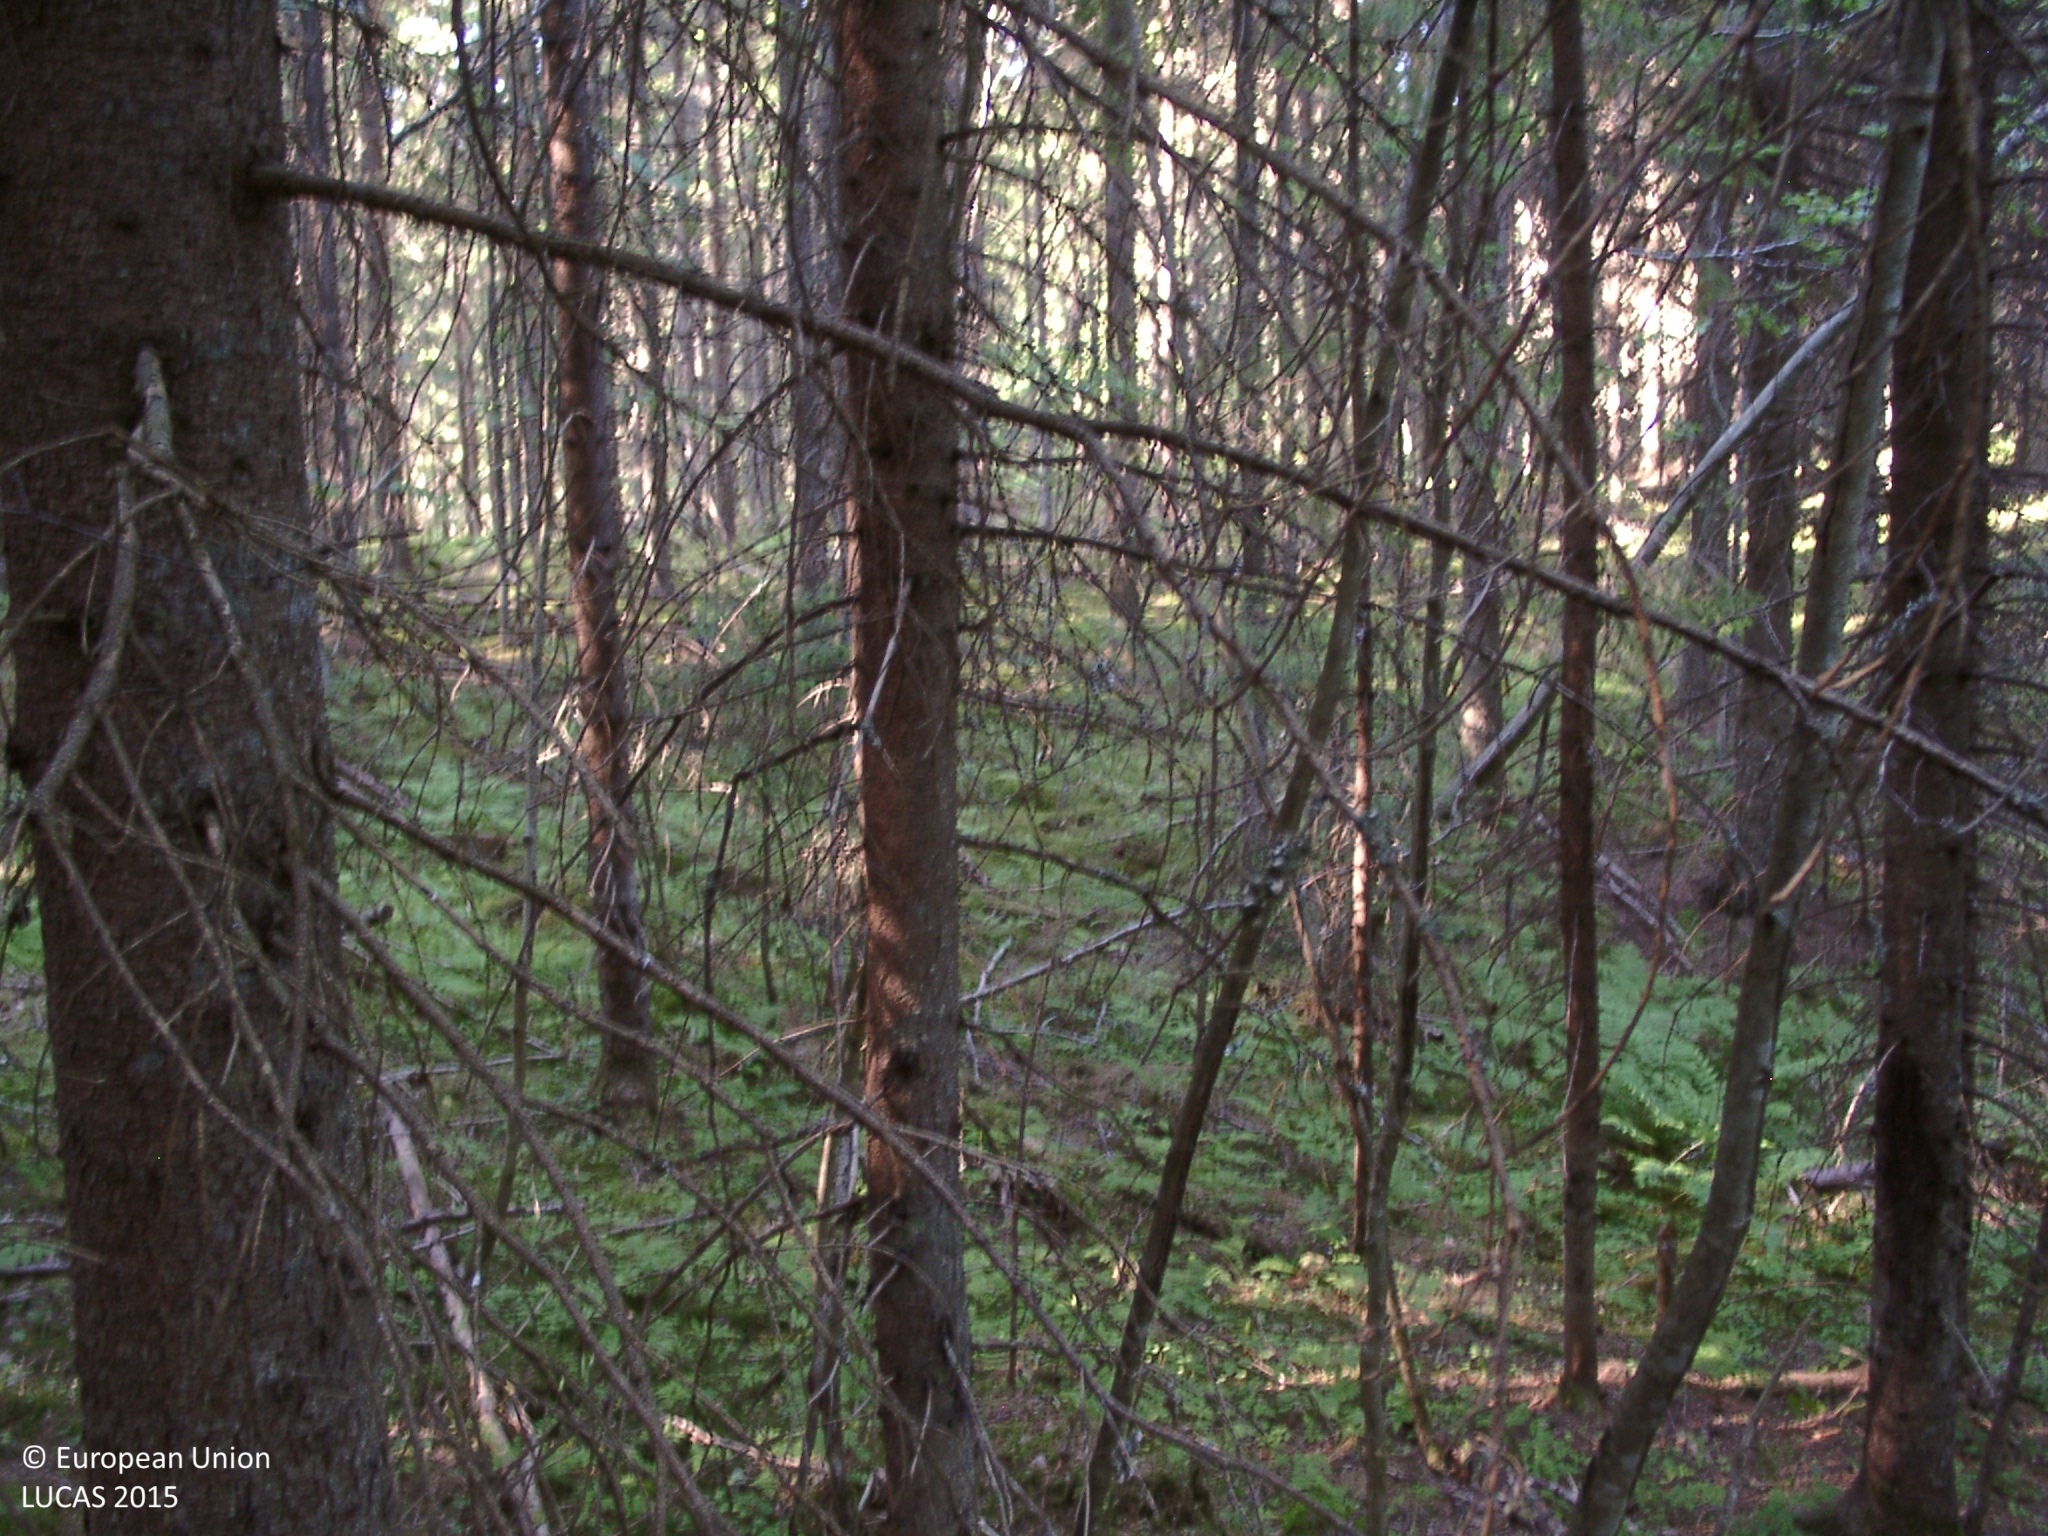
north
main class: Woodland
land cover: Spruce dominated mixed woodland
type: boreal forest
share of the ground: > 75 %
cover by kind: coniferous forest trees 50 %, broadleaved forest trees 40 %, herbaceous plants 5 %, lichens and mosses 5 %
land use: Semi-natural and natural areas not in use
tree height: > 5 m
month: July
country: FI
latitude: 61.9751
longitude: 25.4351
